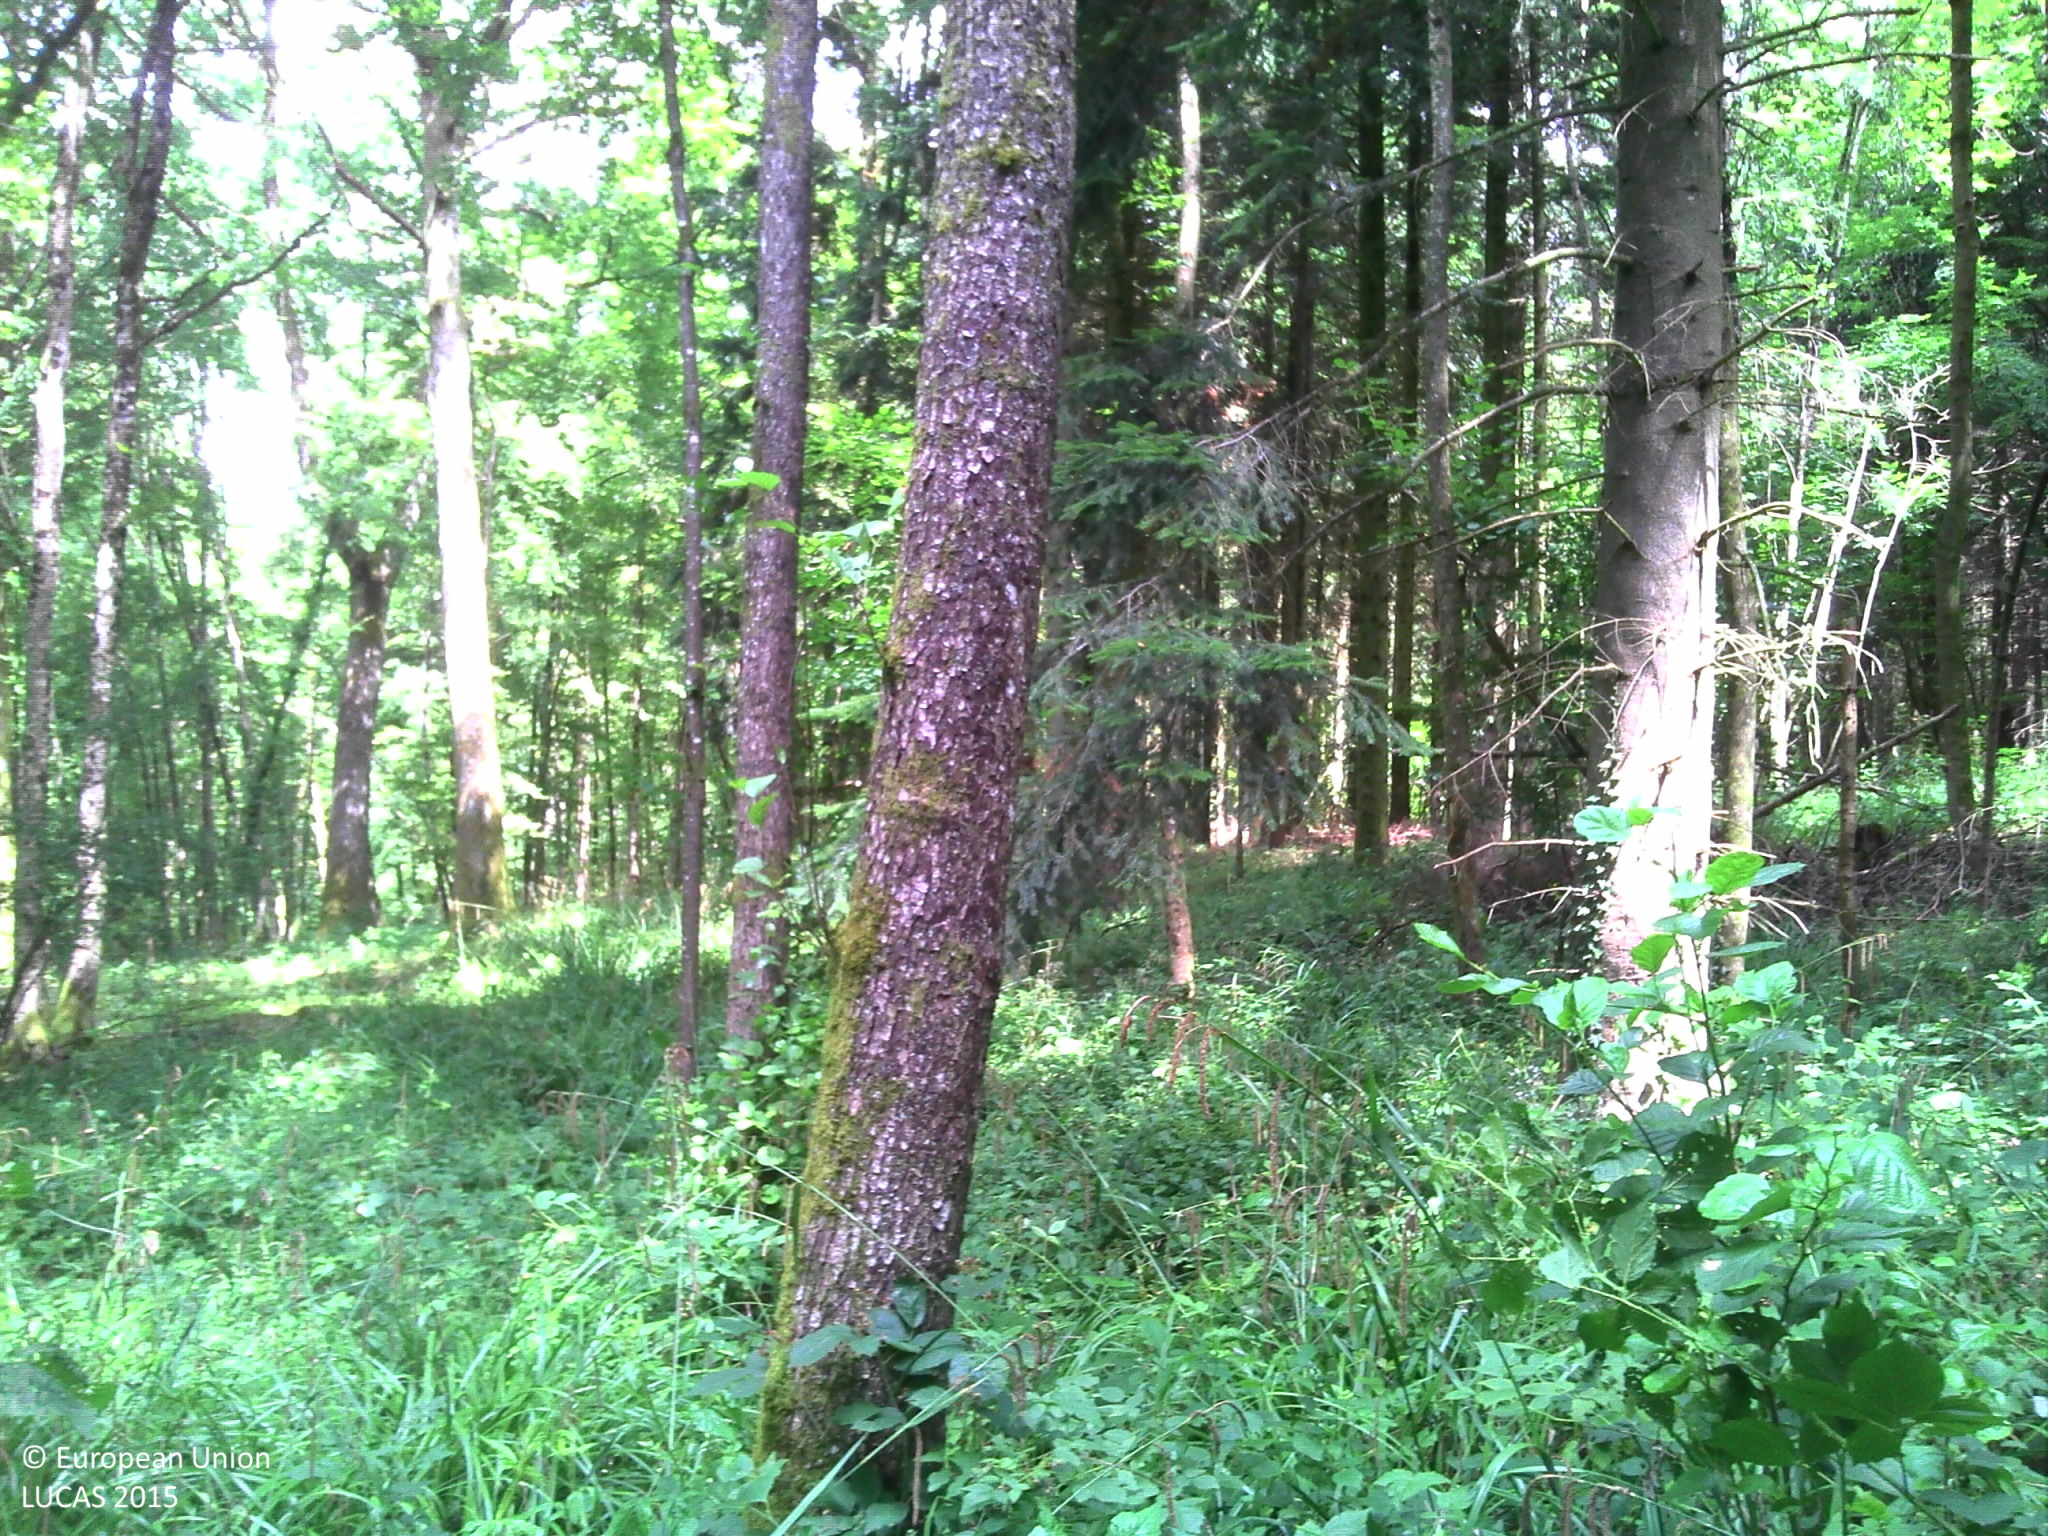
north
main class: Woodland
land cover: Broadleaved woodland
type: mesophytic deciduous forest
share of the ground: > 75 %
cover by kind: broadleaved forest trees 95 %, herbaceous plants 5 %
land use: Forestry
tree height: > 5 m
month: July
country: FR
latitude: 49.1781
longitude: 5.1007
